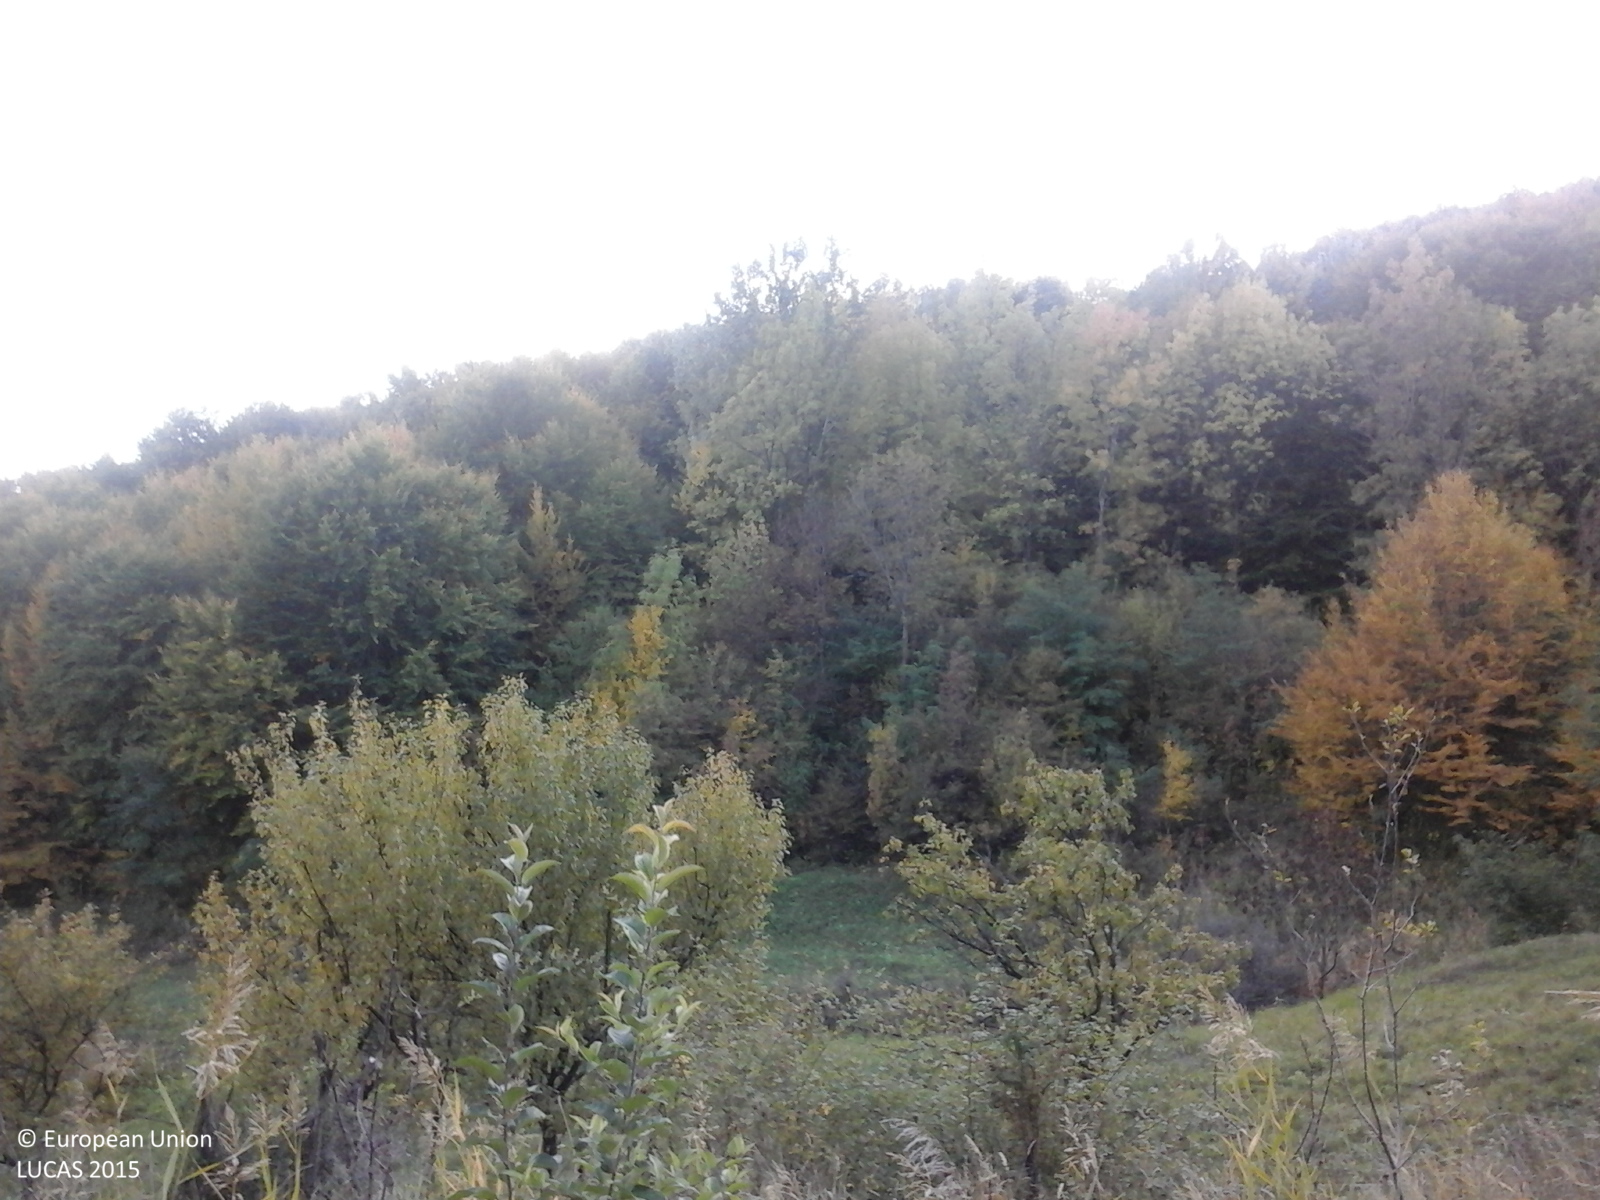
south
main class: Woodland
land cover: Broadleaved woodland
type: acidophilous oak and oak-birch forest
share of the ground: > 75 %
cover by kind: broadleaved forest trees 100 %
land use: Forestry
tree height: > 5 m
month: October
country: RO
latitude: 45.1967
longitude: 26.3227
